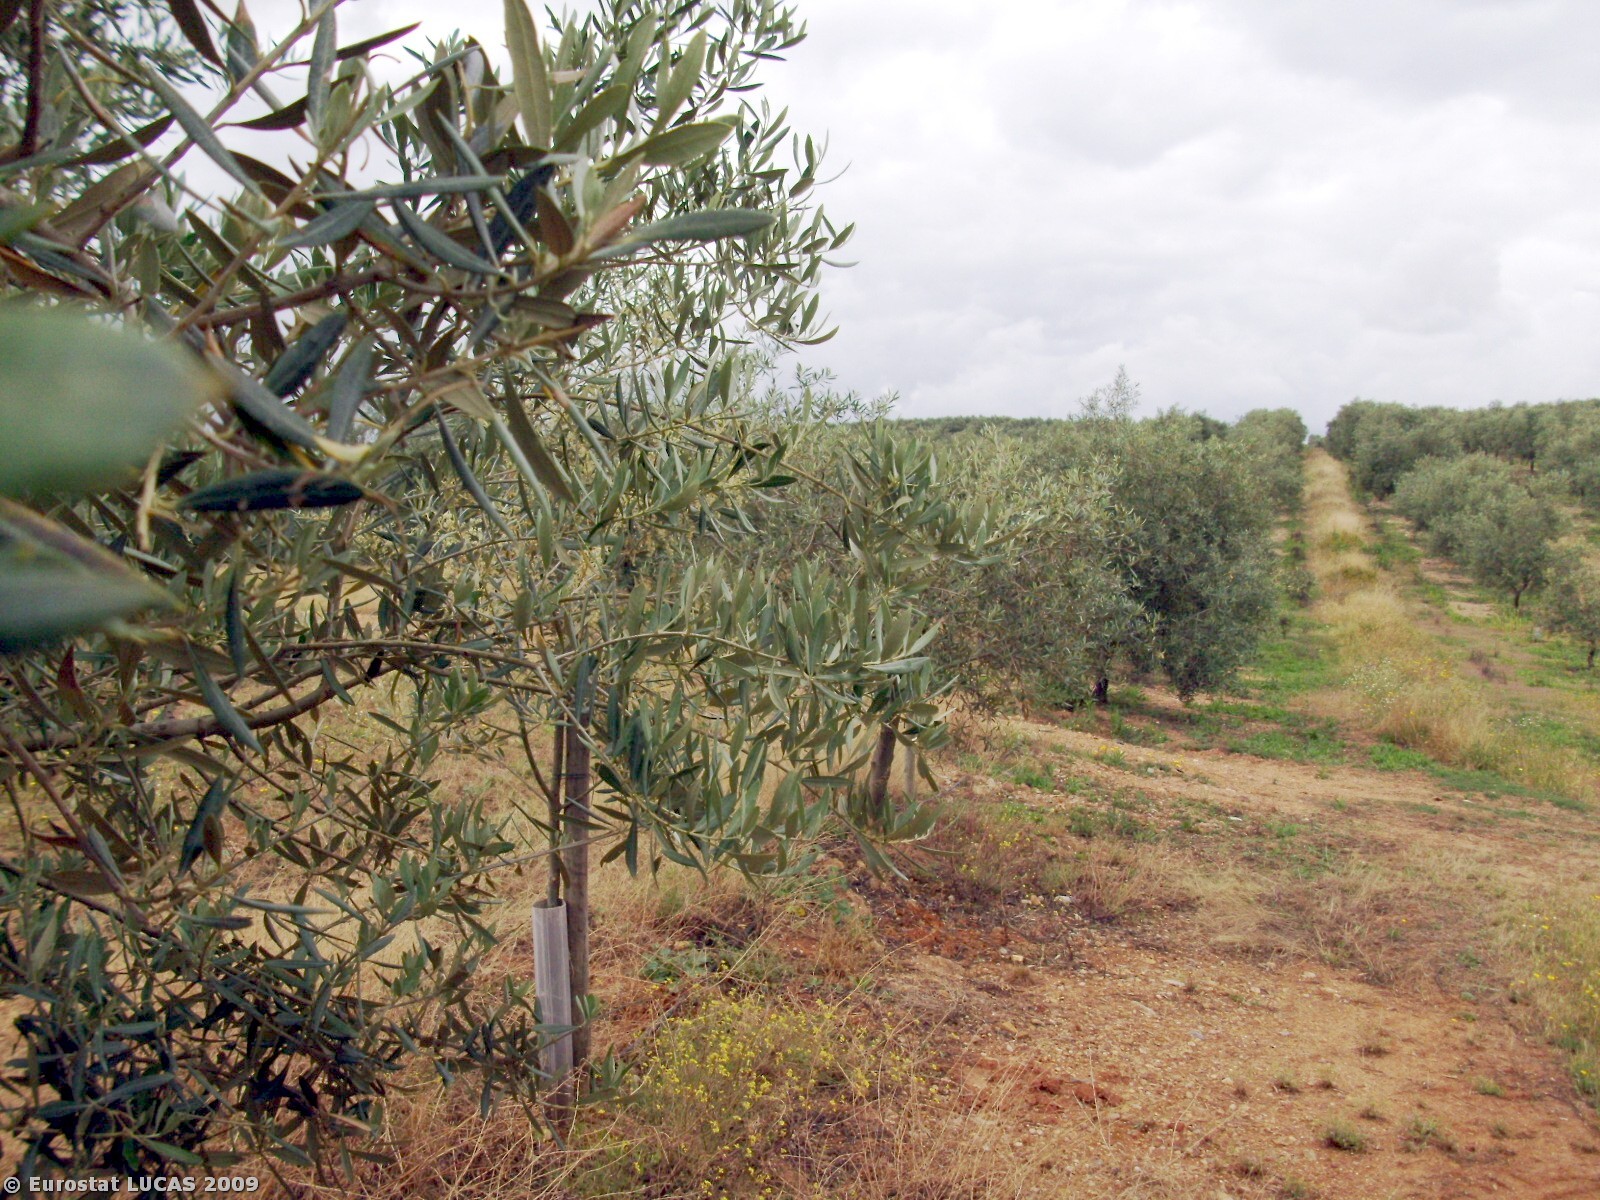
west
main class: Cropland
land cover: Olive groves
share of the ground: 25 - 50 %
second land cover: Spontaneously vegetated surfaces
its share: 50 - 75 %
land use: Agriculture (excluding fallow land and kitchen gardens)
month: May
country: PT
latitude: 39.1934
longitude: -7.8217
